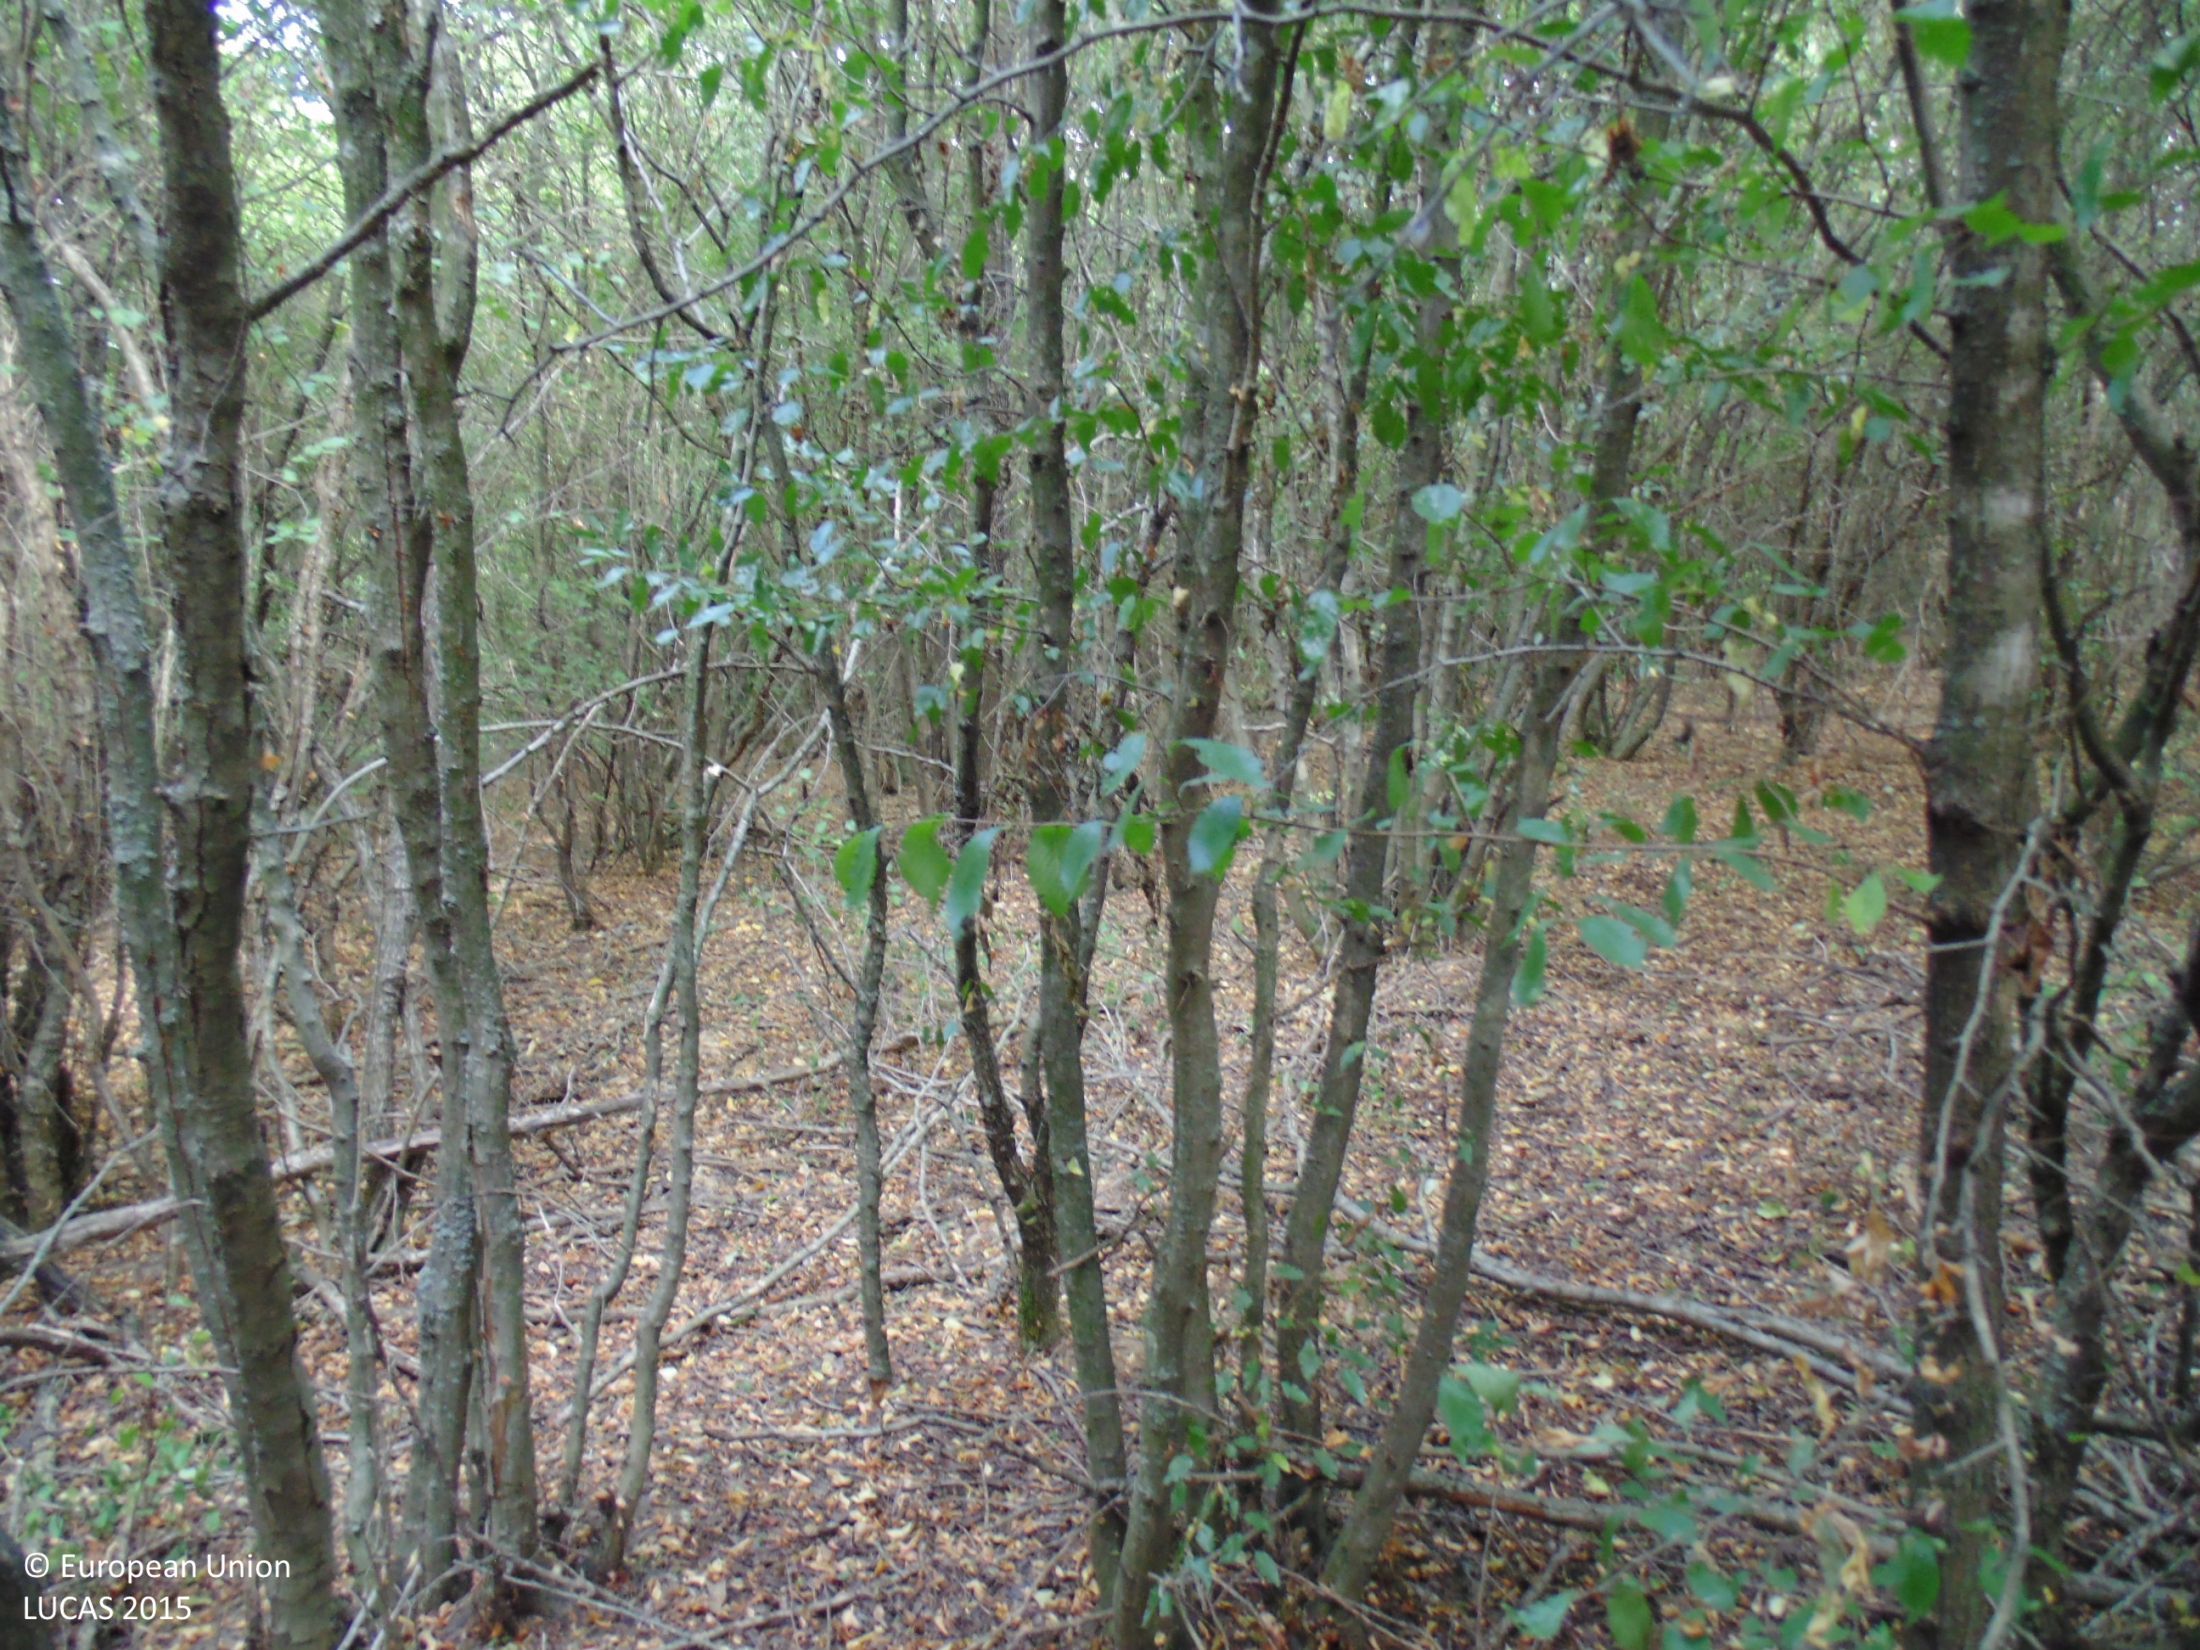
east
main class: Woodland
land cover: Broadleaved woodland
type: mesophytic deciduous forest
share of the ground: > 75 %
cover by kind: broadleaved forest trees 95 %, unconsolidated bare surface 5 %
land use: Forestry
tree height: > 5 m
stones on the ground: < 10 %
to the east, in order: Broadleaved woodland; Grassland with sparse tree/shrub cover; Tracks; Grass margins; Rivers and streams; Grassland without tree/shrub cover; Grassland with sparse tree/shrub cover; Rivers and streams; Grass margins; Tracks; Grassland with sparse tree/shrub cover; Broadleaved woodland
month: August
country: BG
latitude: 43.9127
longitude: 27.6359
